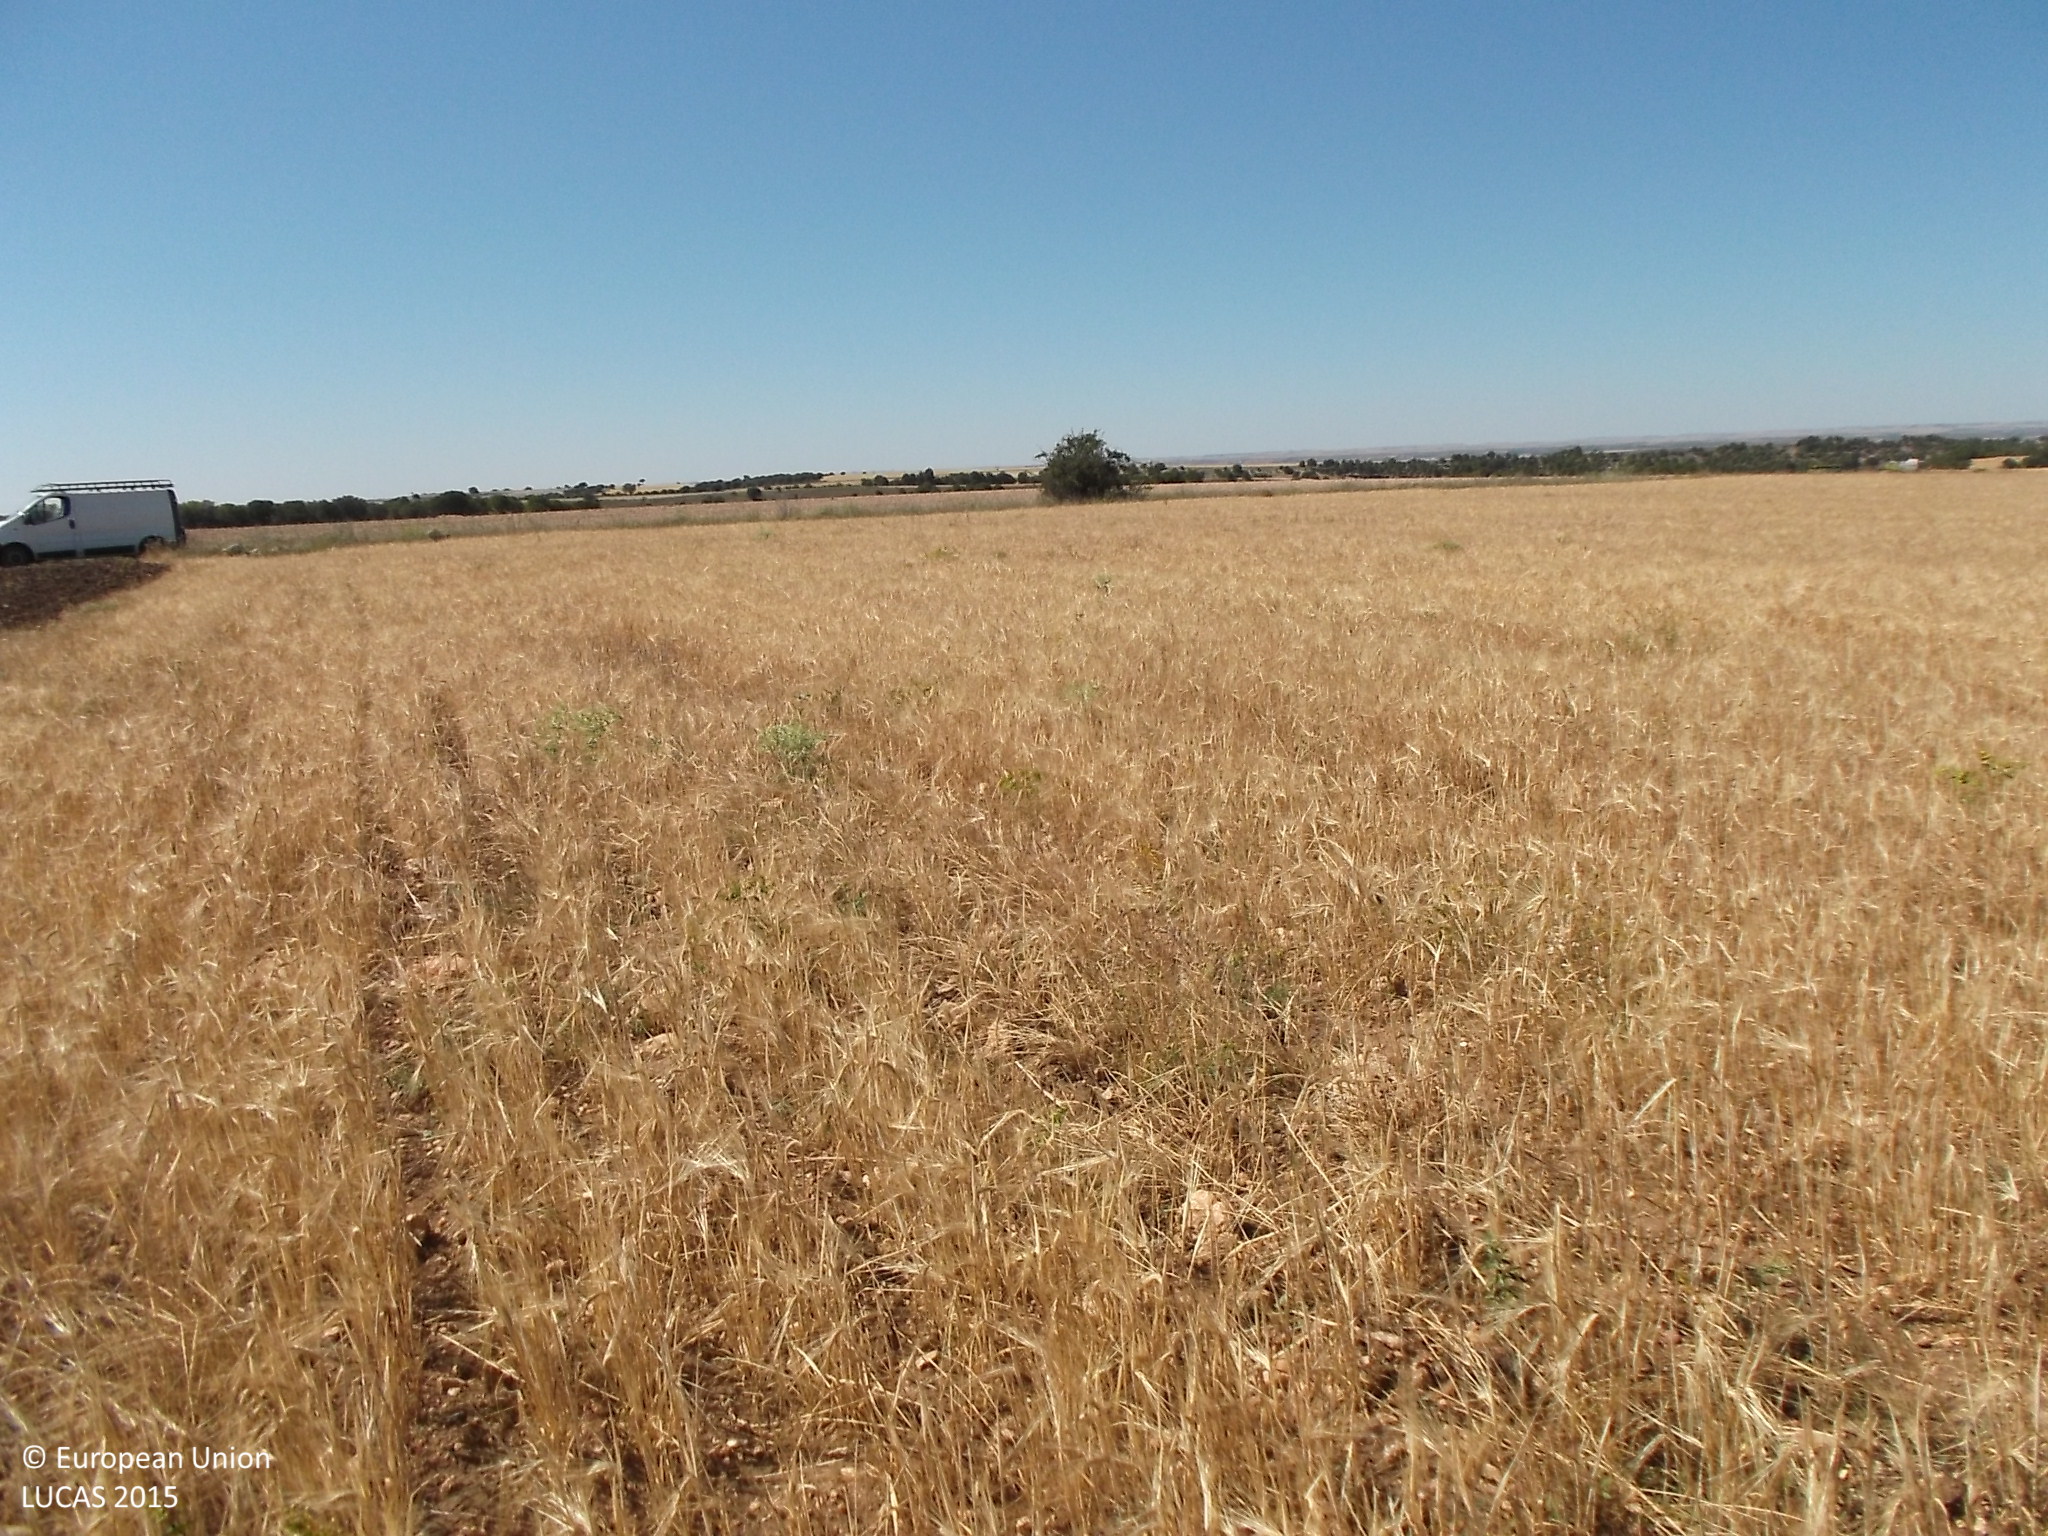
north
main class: Cropland
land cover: Barley
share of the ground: > 75 %
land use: Agriculture (excluding fallow land and kitchen gardens)
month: June
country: ES
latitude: 41.3705
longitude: -5.3197
